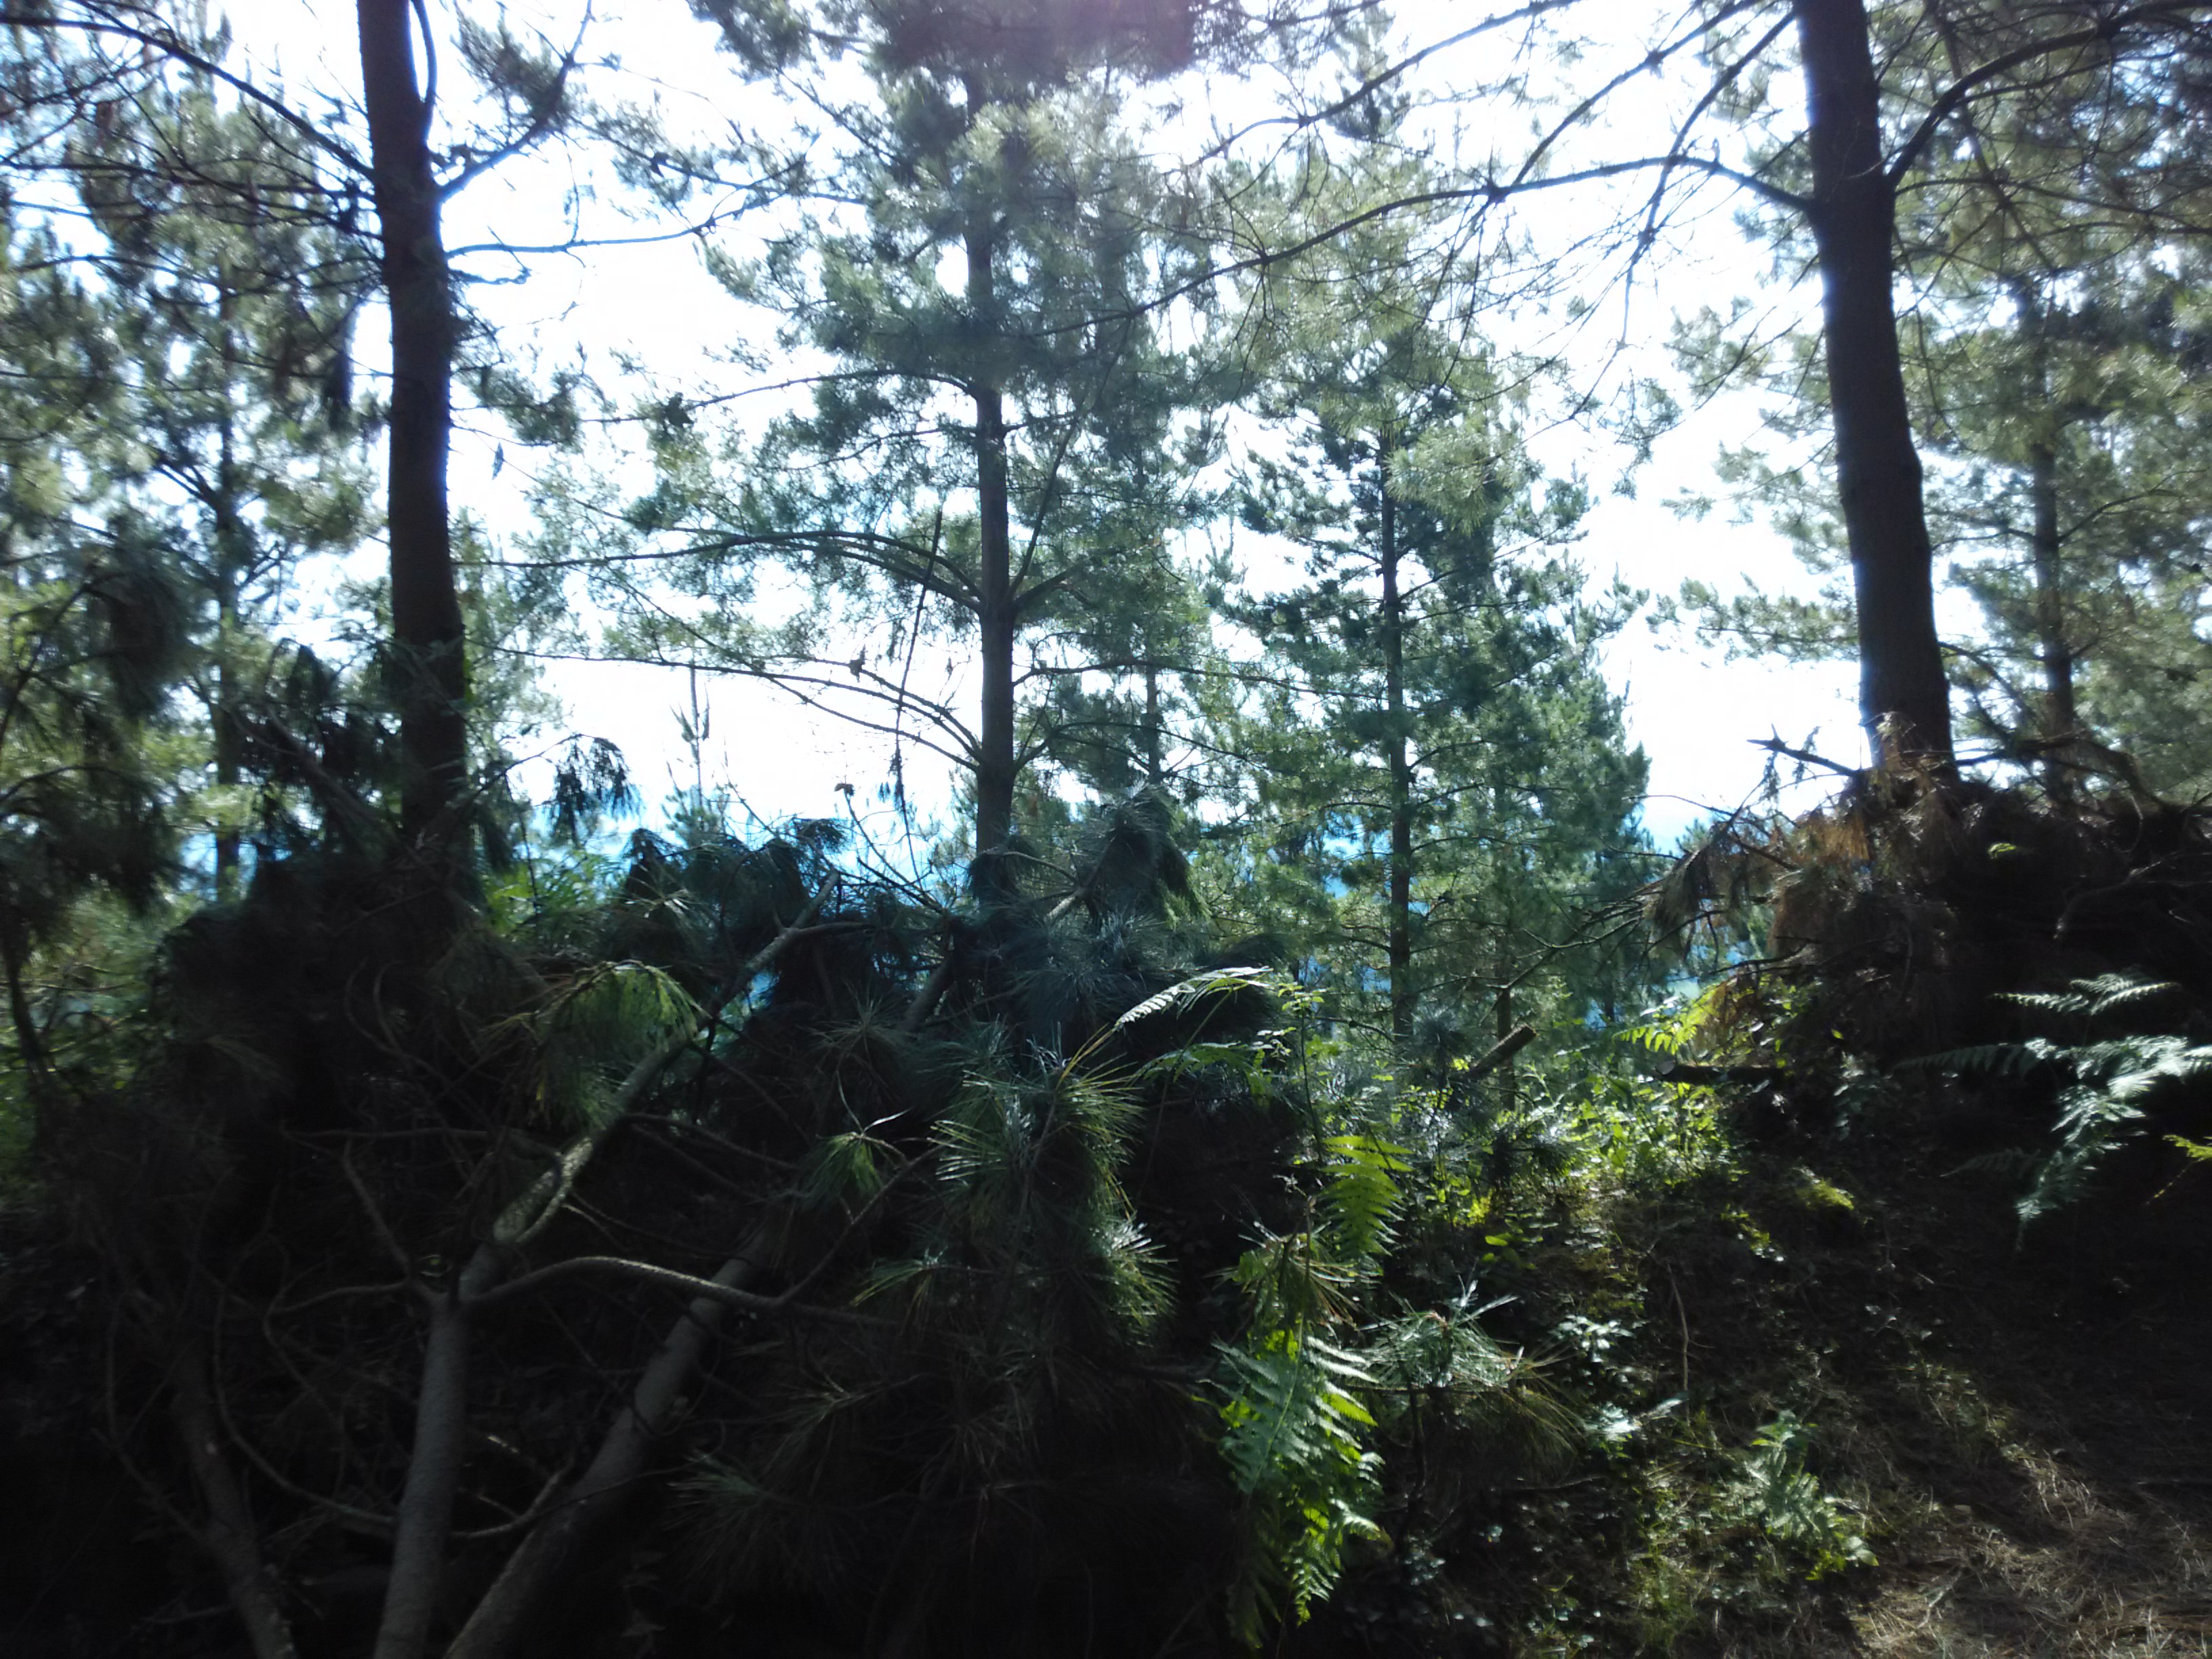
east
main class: Woodland
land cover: Pine dominated coniferous woodland
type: exotic forest
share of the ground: > 75 %
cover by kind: coniferous forest trees 85 %, herbaceous plants 10 %, unconsolidated bare surface 5 %
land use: Forestry
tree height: > 5 m
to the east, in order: Pine dominated coniferous woodland; Tracks; Pine dominated coniferous woodland; Tracks; Pine dominated coniferous woodland
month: July
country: ES
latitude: 43.1586
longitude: -2.3112
